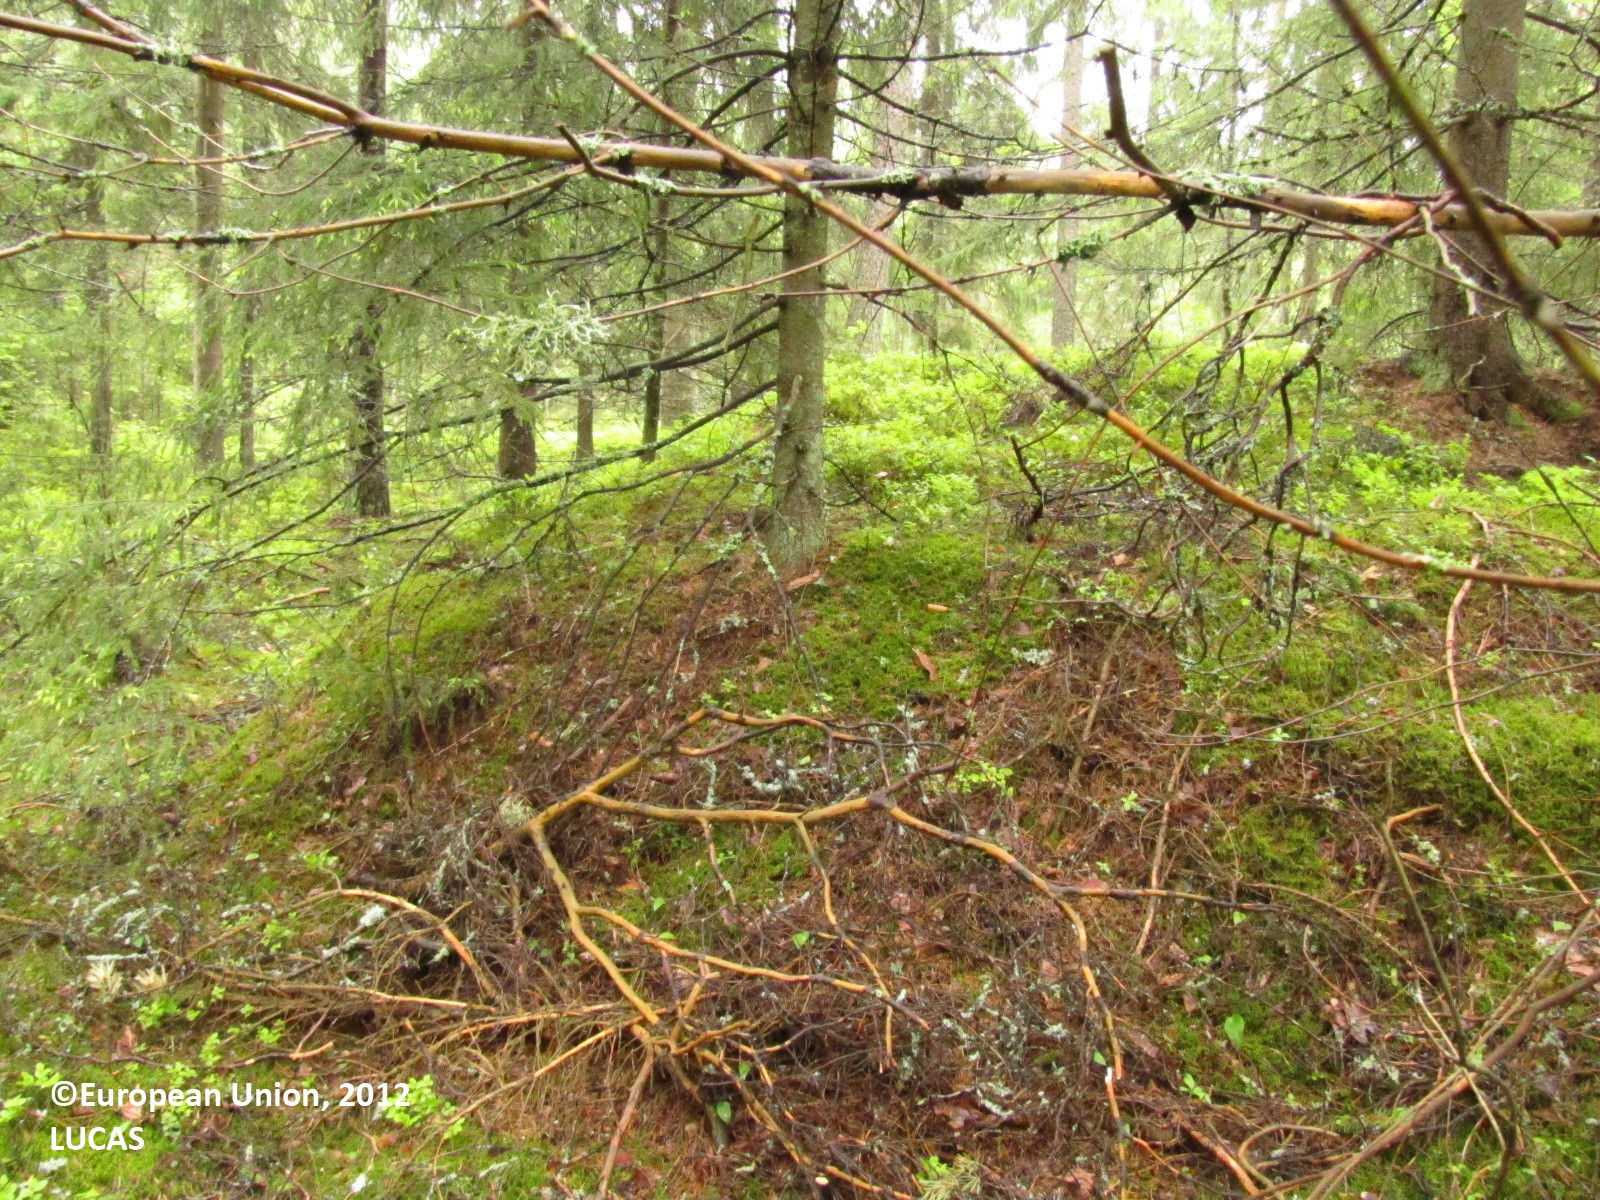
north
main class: Woodland
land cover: Spruce dominated coniferous woodland
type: hemiboreal forest and nemoral coniferous forest and mixed broadleaved-coniferous forest
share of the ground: > 75 %
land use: Forestry
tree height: > 5 m
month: June
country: FI
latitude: 61.4809
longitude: 22.9692
